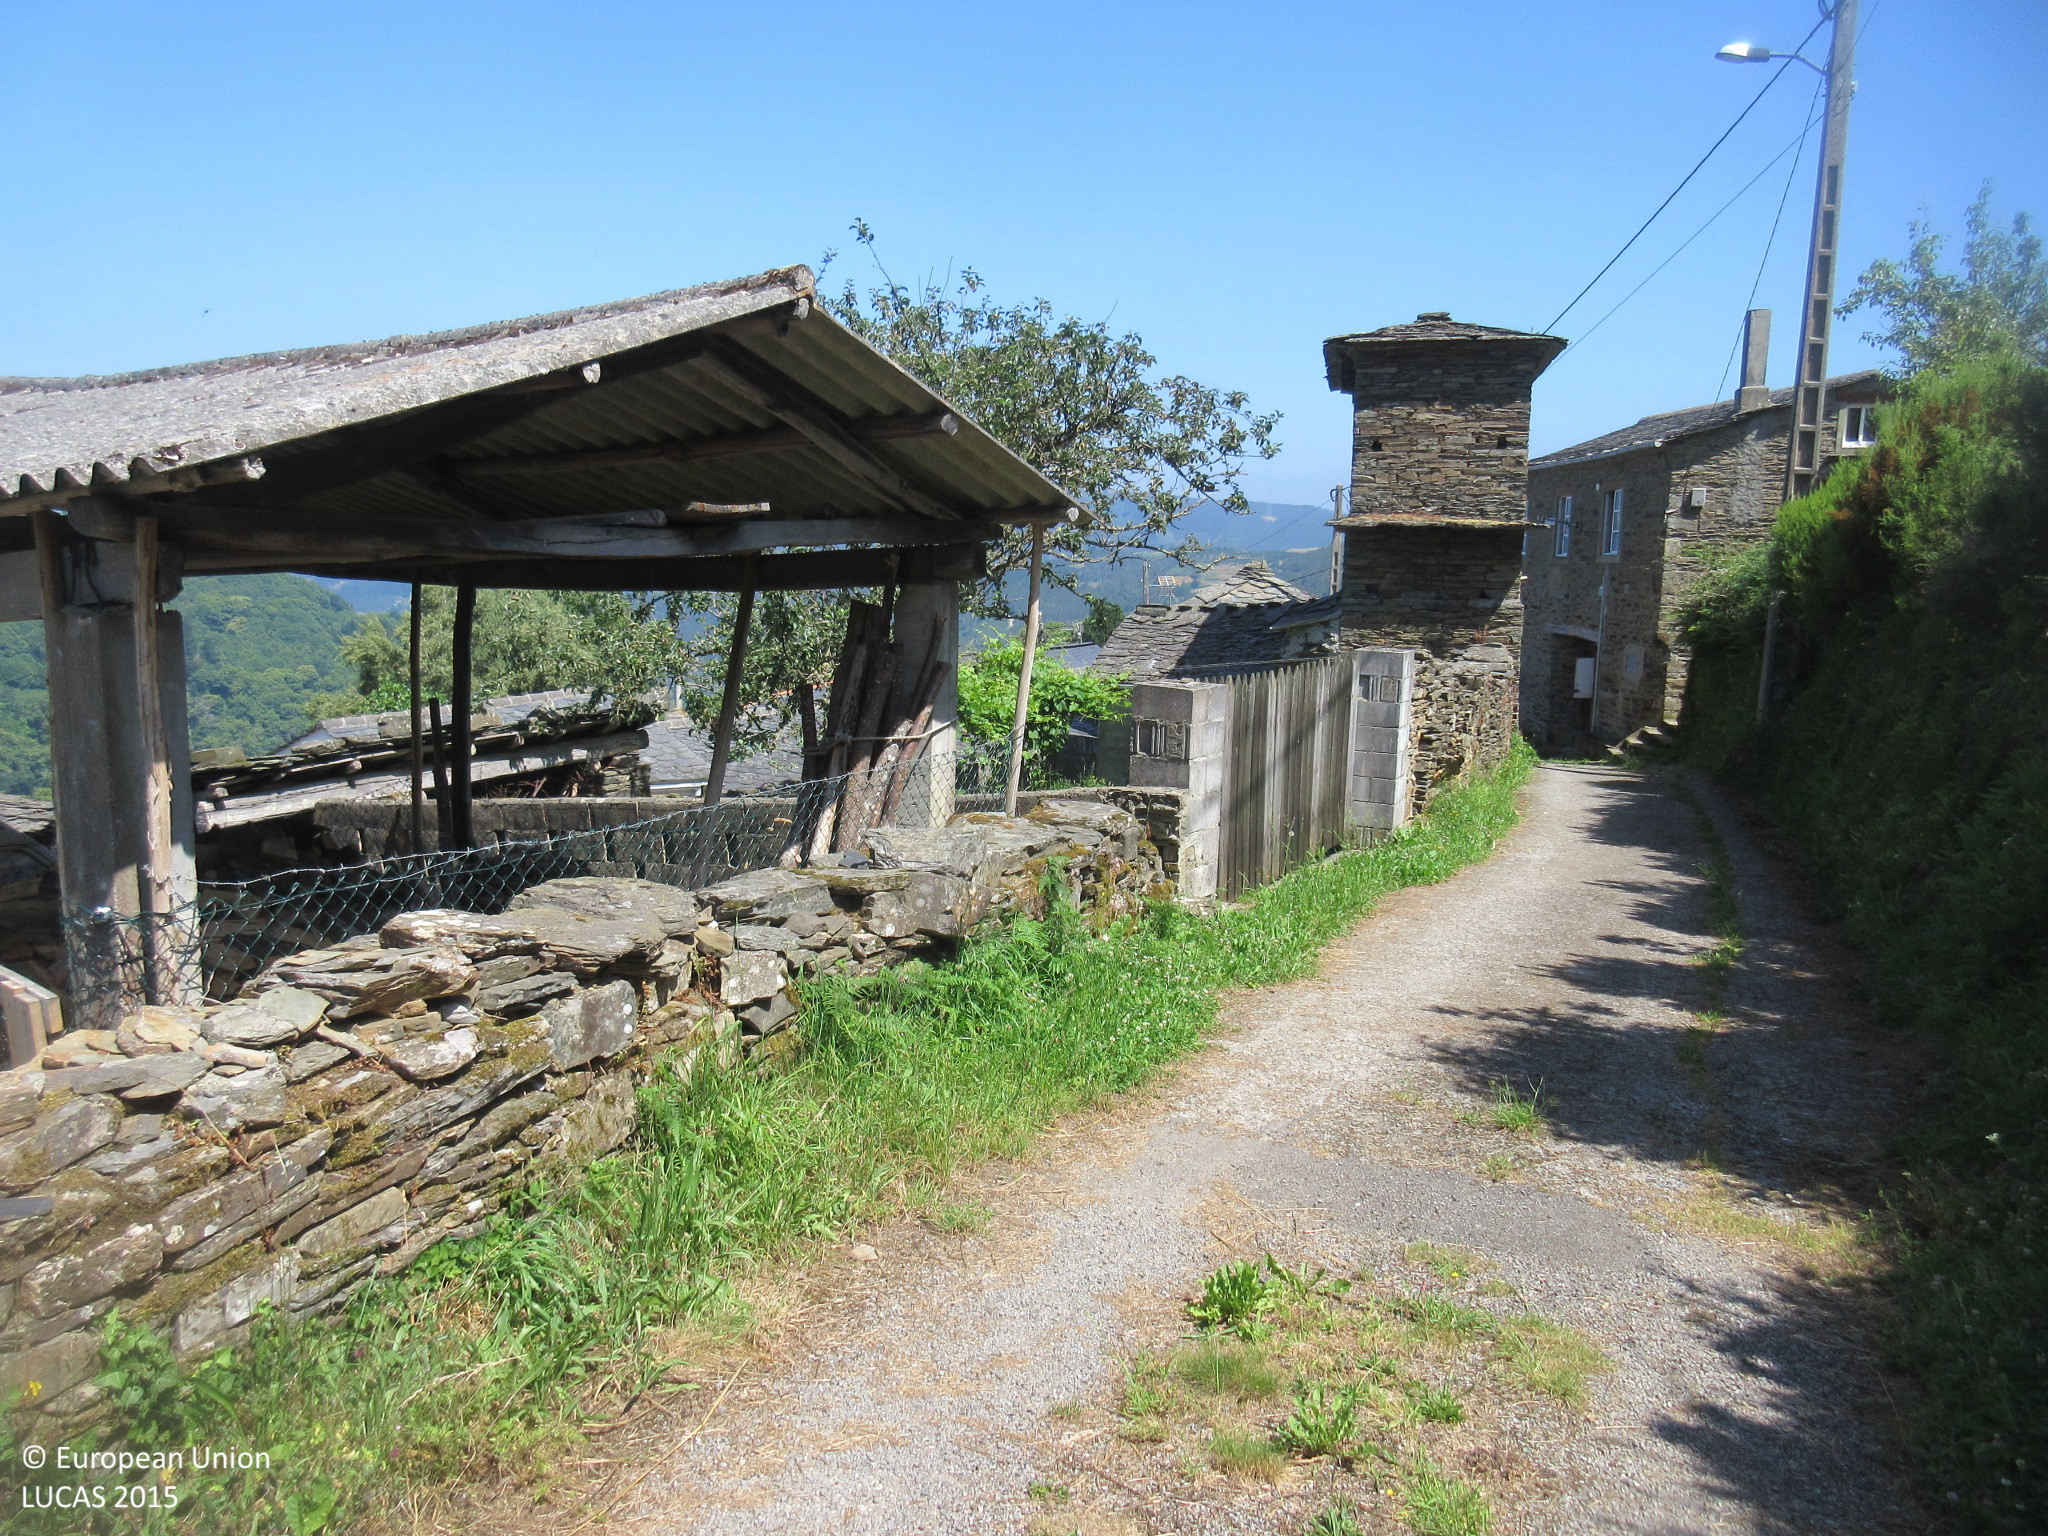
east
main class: Grassland
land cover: Grassland with sparse tree/shrub cover
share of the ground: > 75 %
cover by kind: herbaceous plants 95 %, broadleaved forest trees 5 %
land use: Agriculture (excluding fallow land and kitchen gardens)
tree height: < 5 m
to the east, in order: Grassland with sparse tree/shrub cover; Broadleaved woodland; Grass margins; Tracks; Grass margins; Broadleaved woodland; Pine dominated coniferous woodland; Dry stone walls; Tracks; Shrubland with sparse tree cover
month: June
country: ES
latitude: 43.2978
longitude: -7.1414
